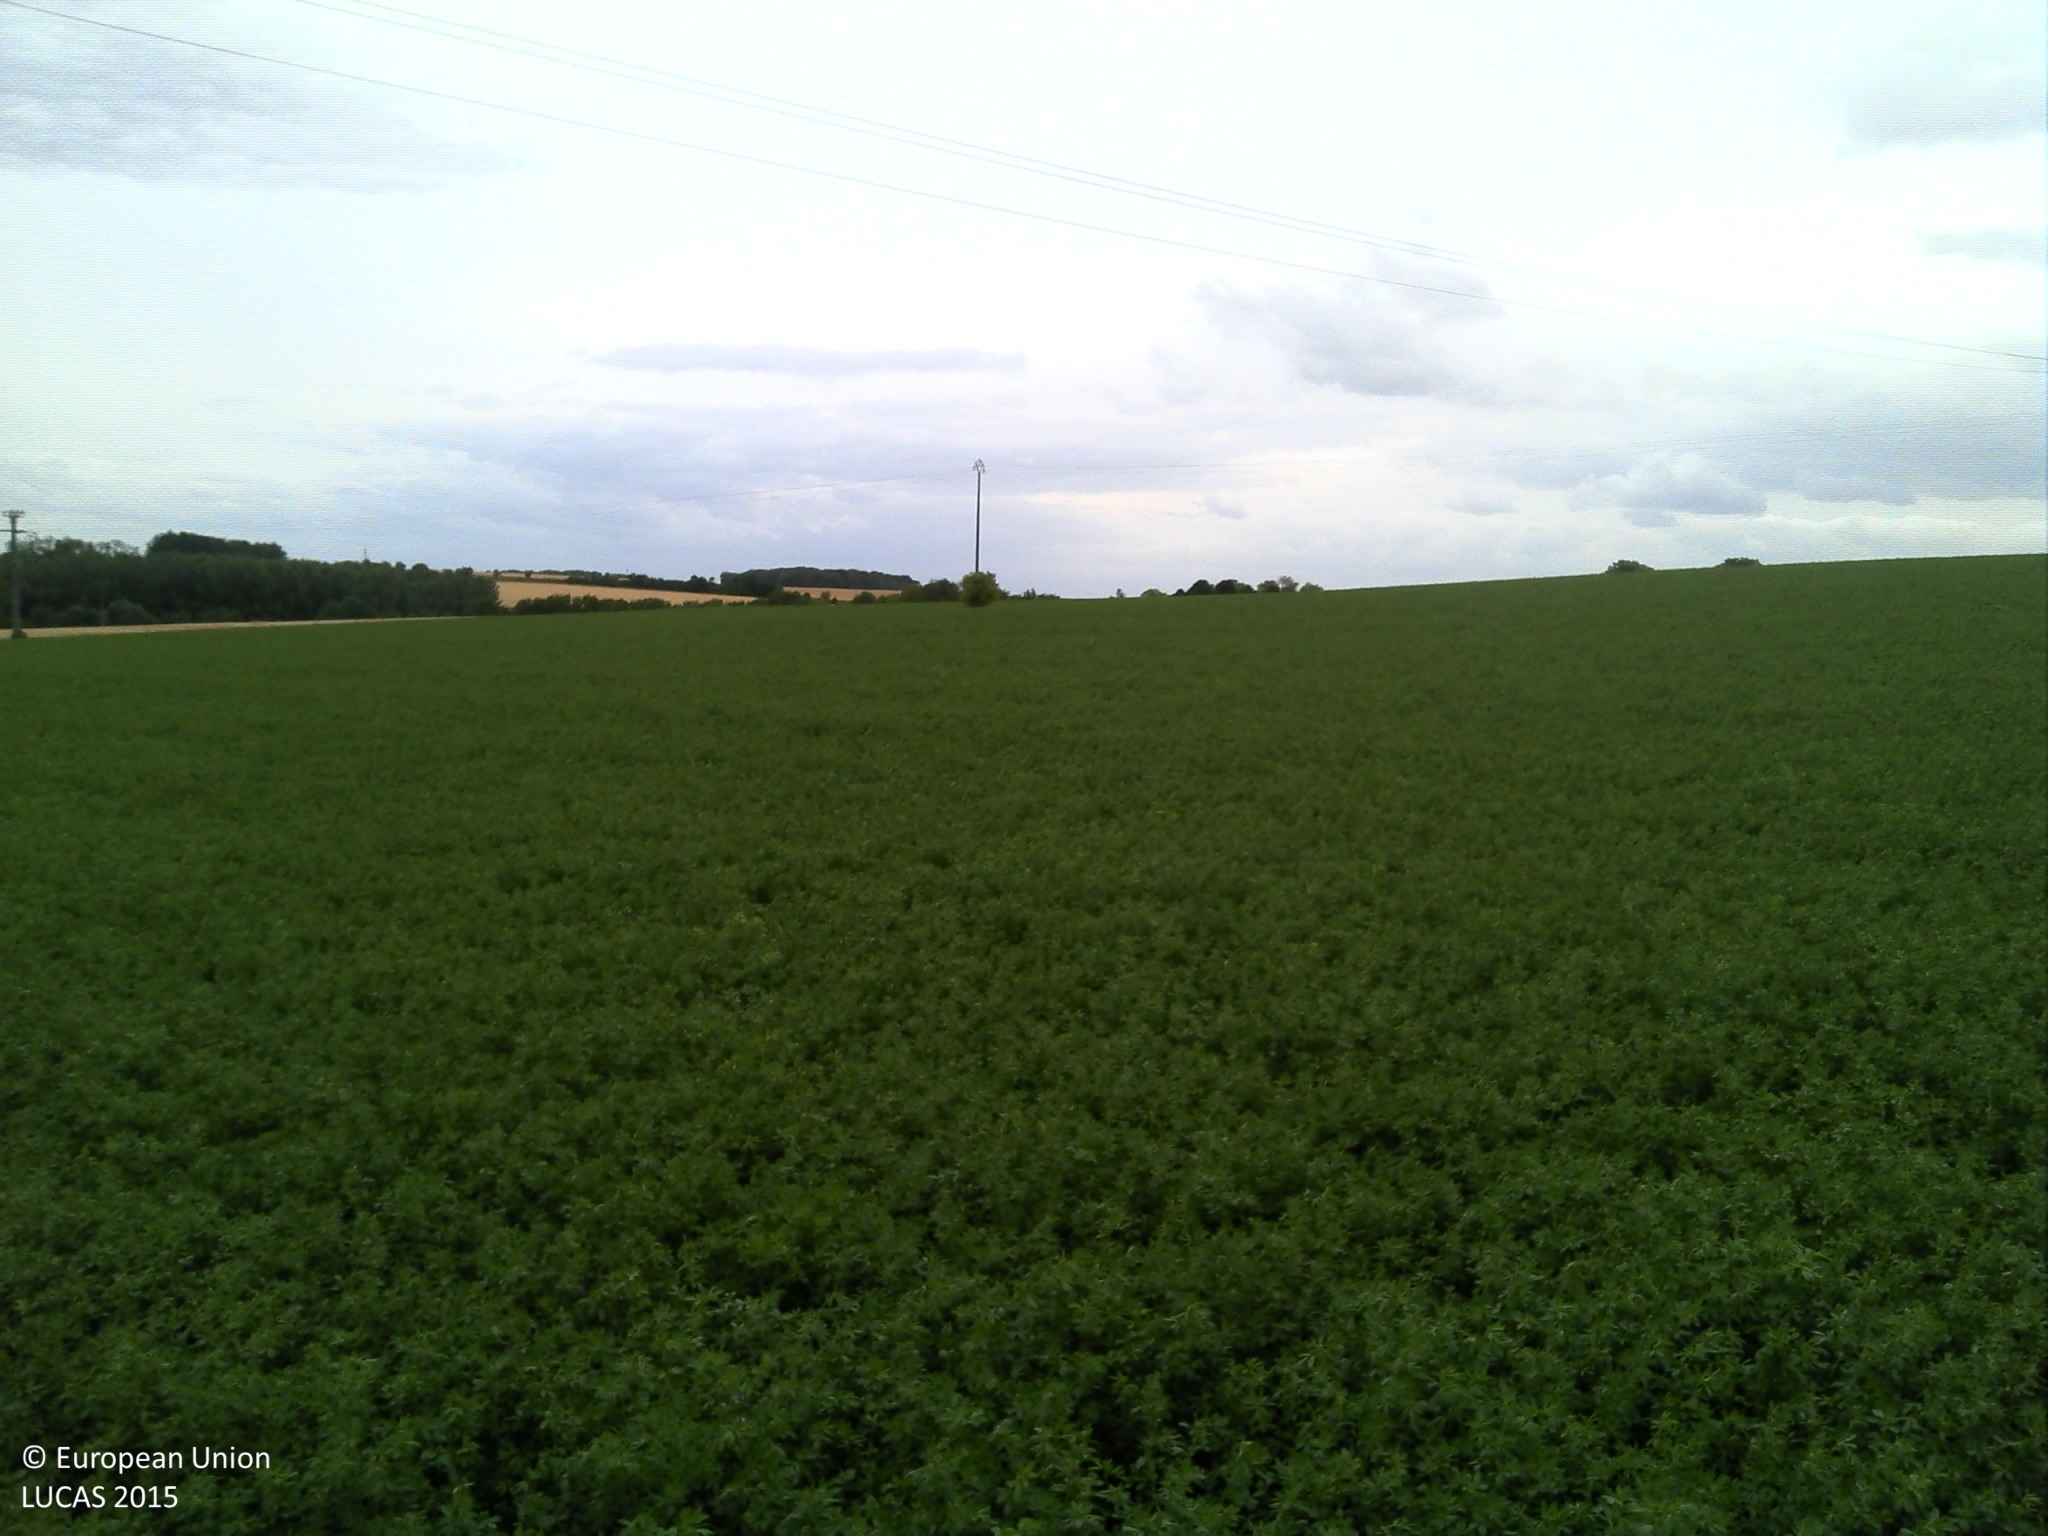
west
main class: Cropland
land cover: Lucerne
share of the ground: > 75 %
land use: Agriculture (excluding fallow land and kitchen gardens)
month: July
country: FR
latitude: 49.5443
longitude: 4.0936
